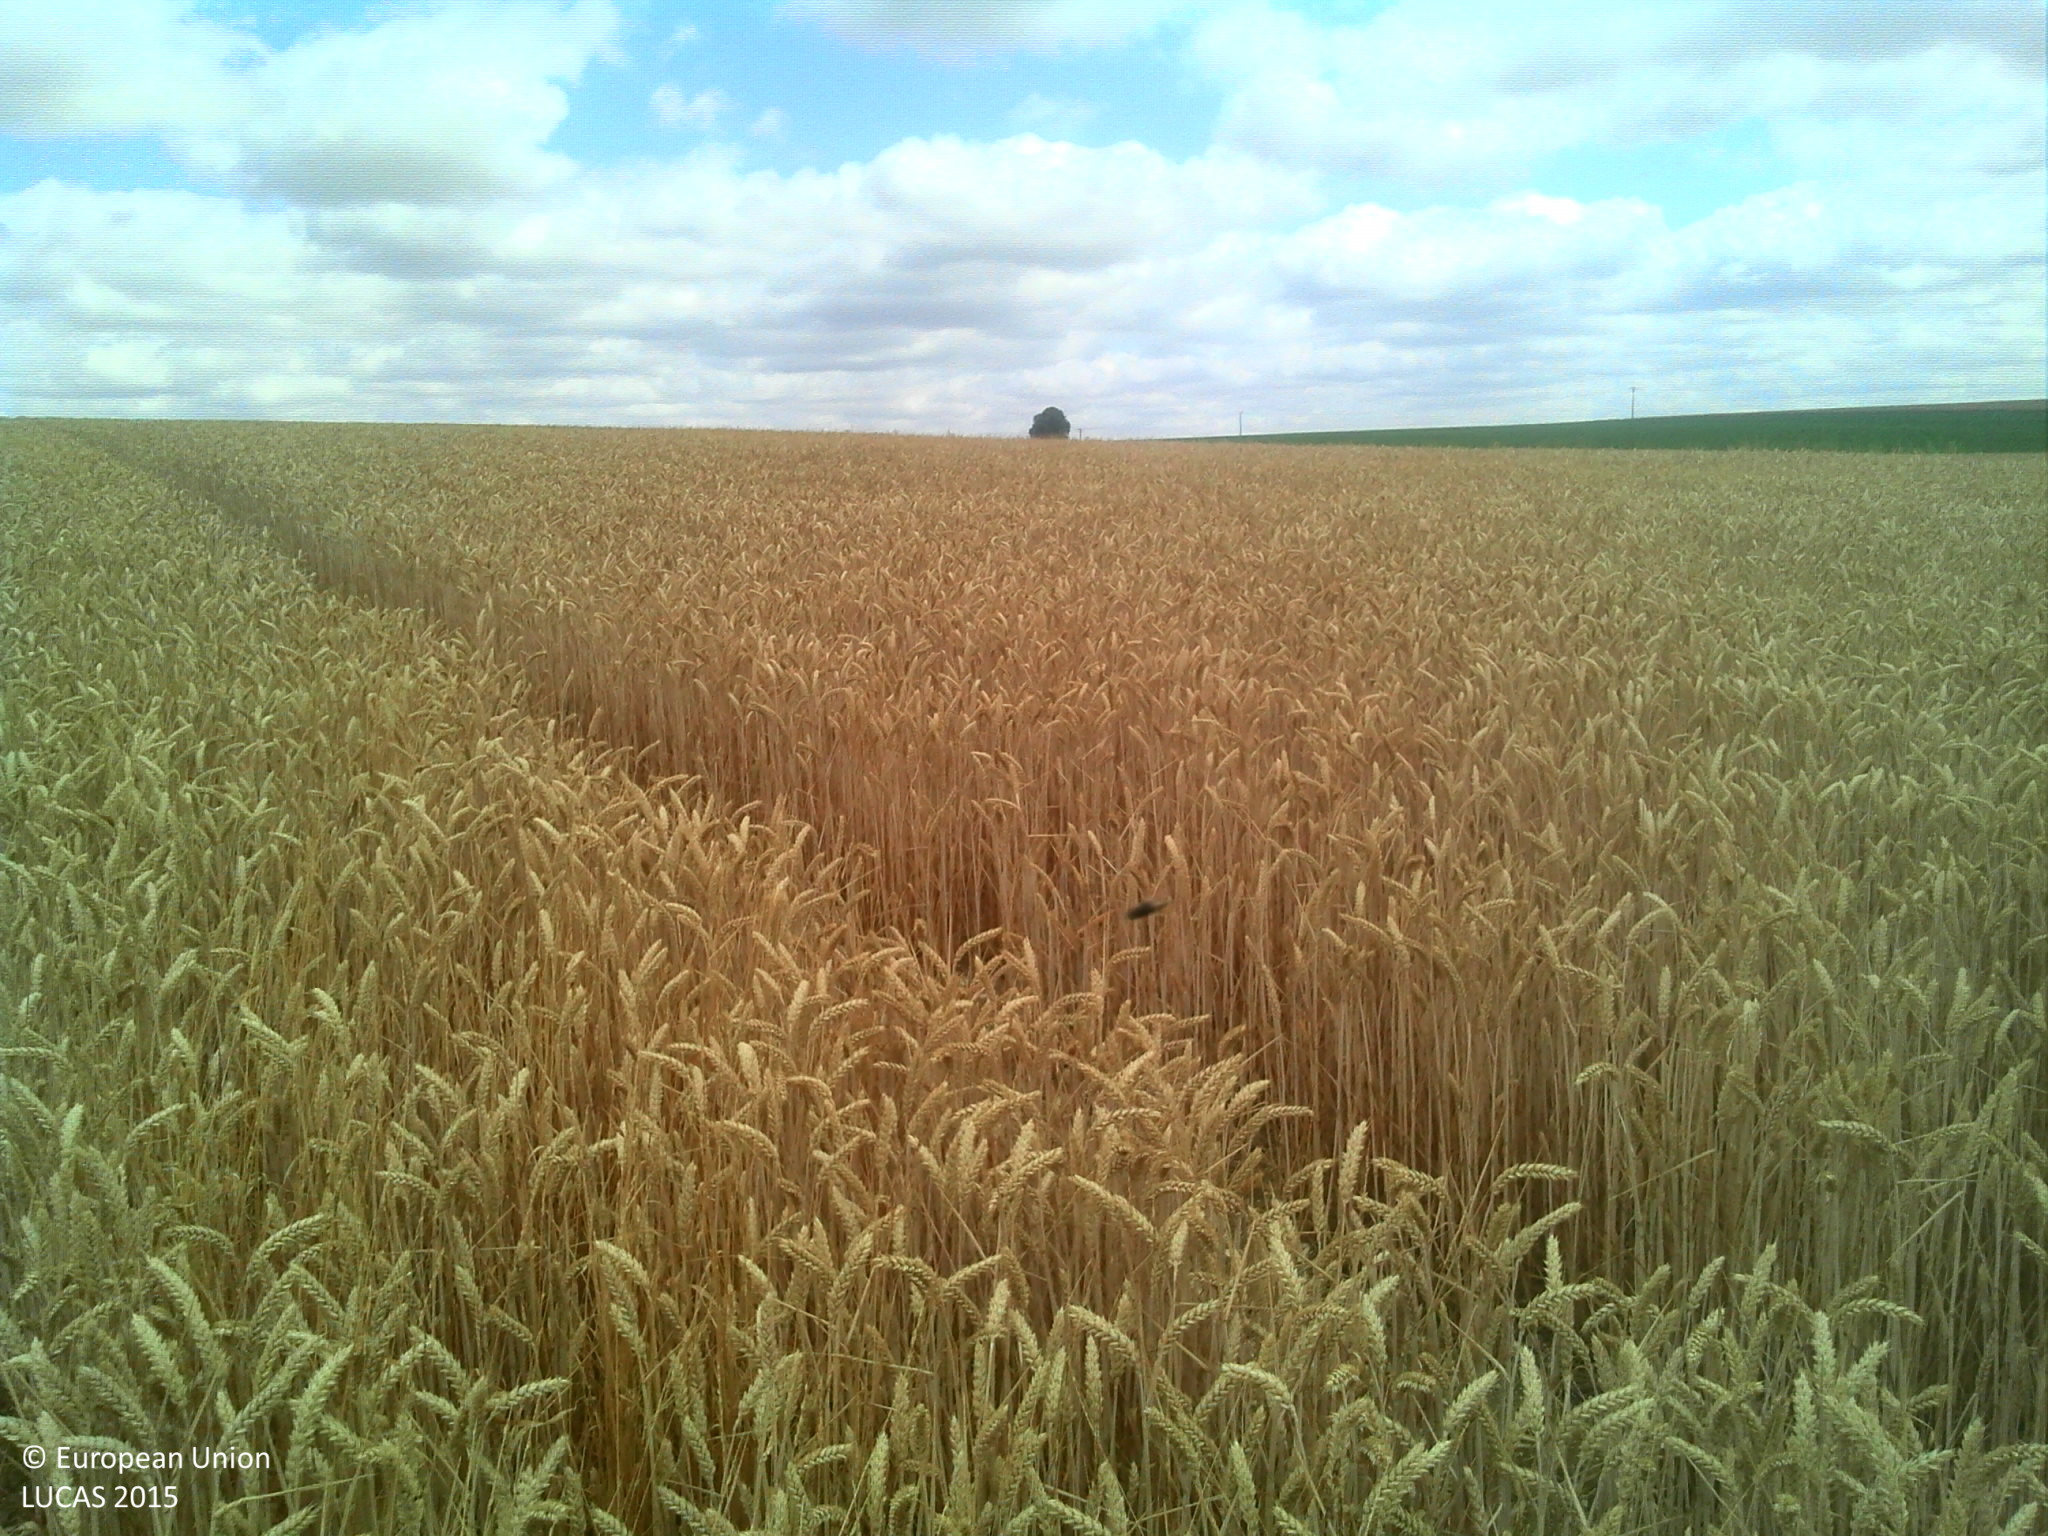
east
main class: Cropland
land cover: Common wheat
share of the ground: > 75 %
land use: Agriculture (excluding fallow land and kitchen gardens)
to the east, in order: Common wheat
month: July
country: FR
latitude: 49.2311
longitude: 3.3320
